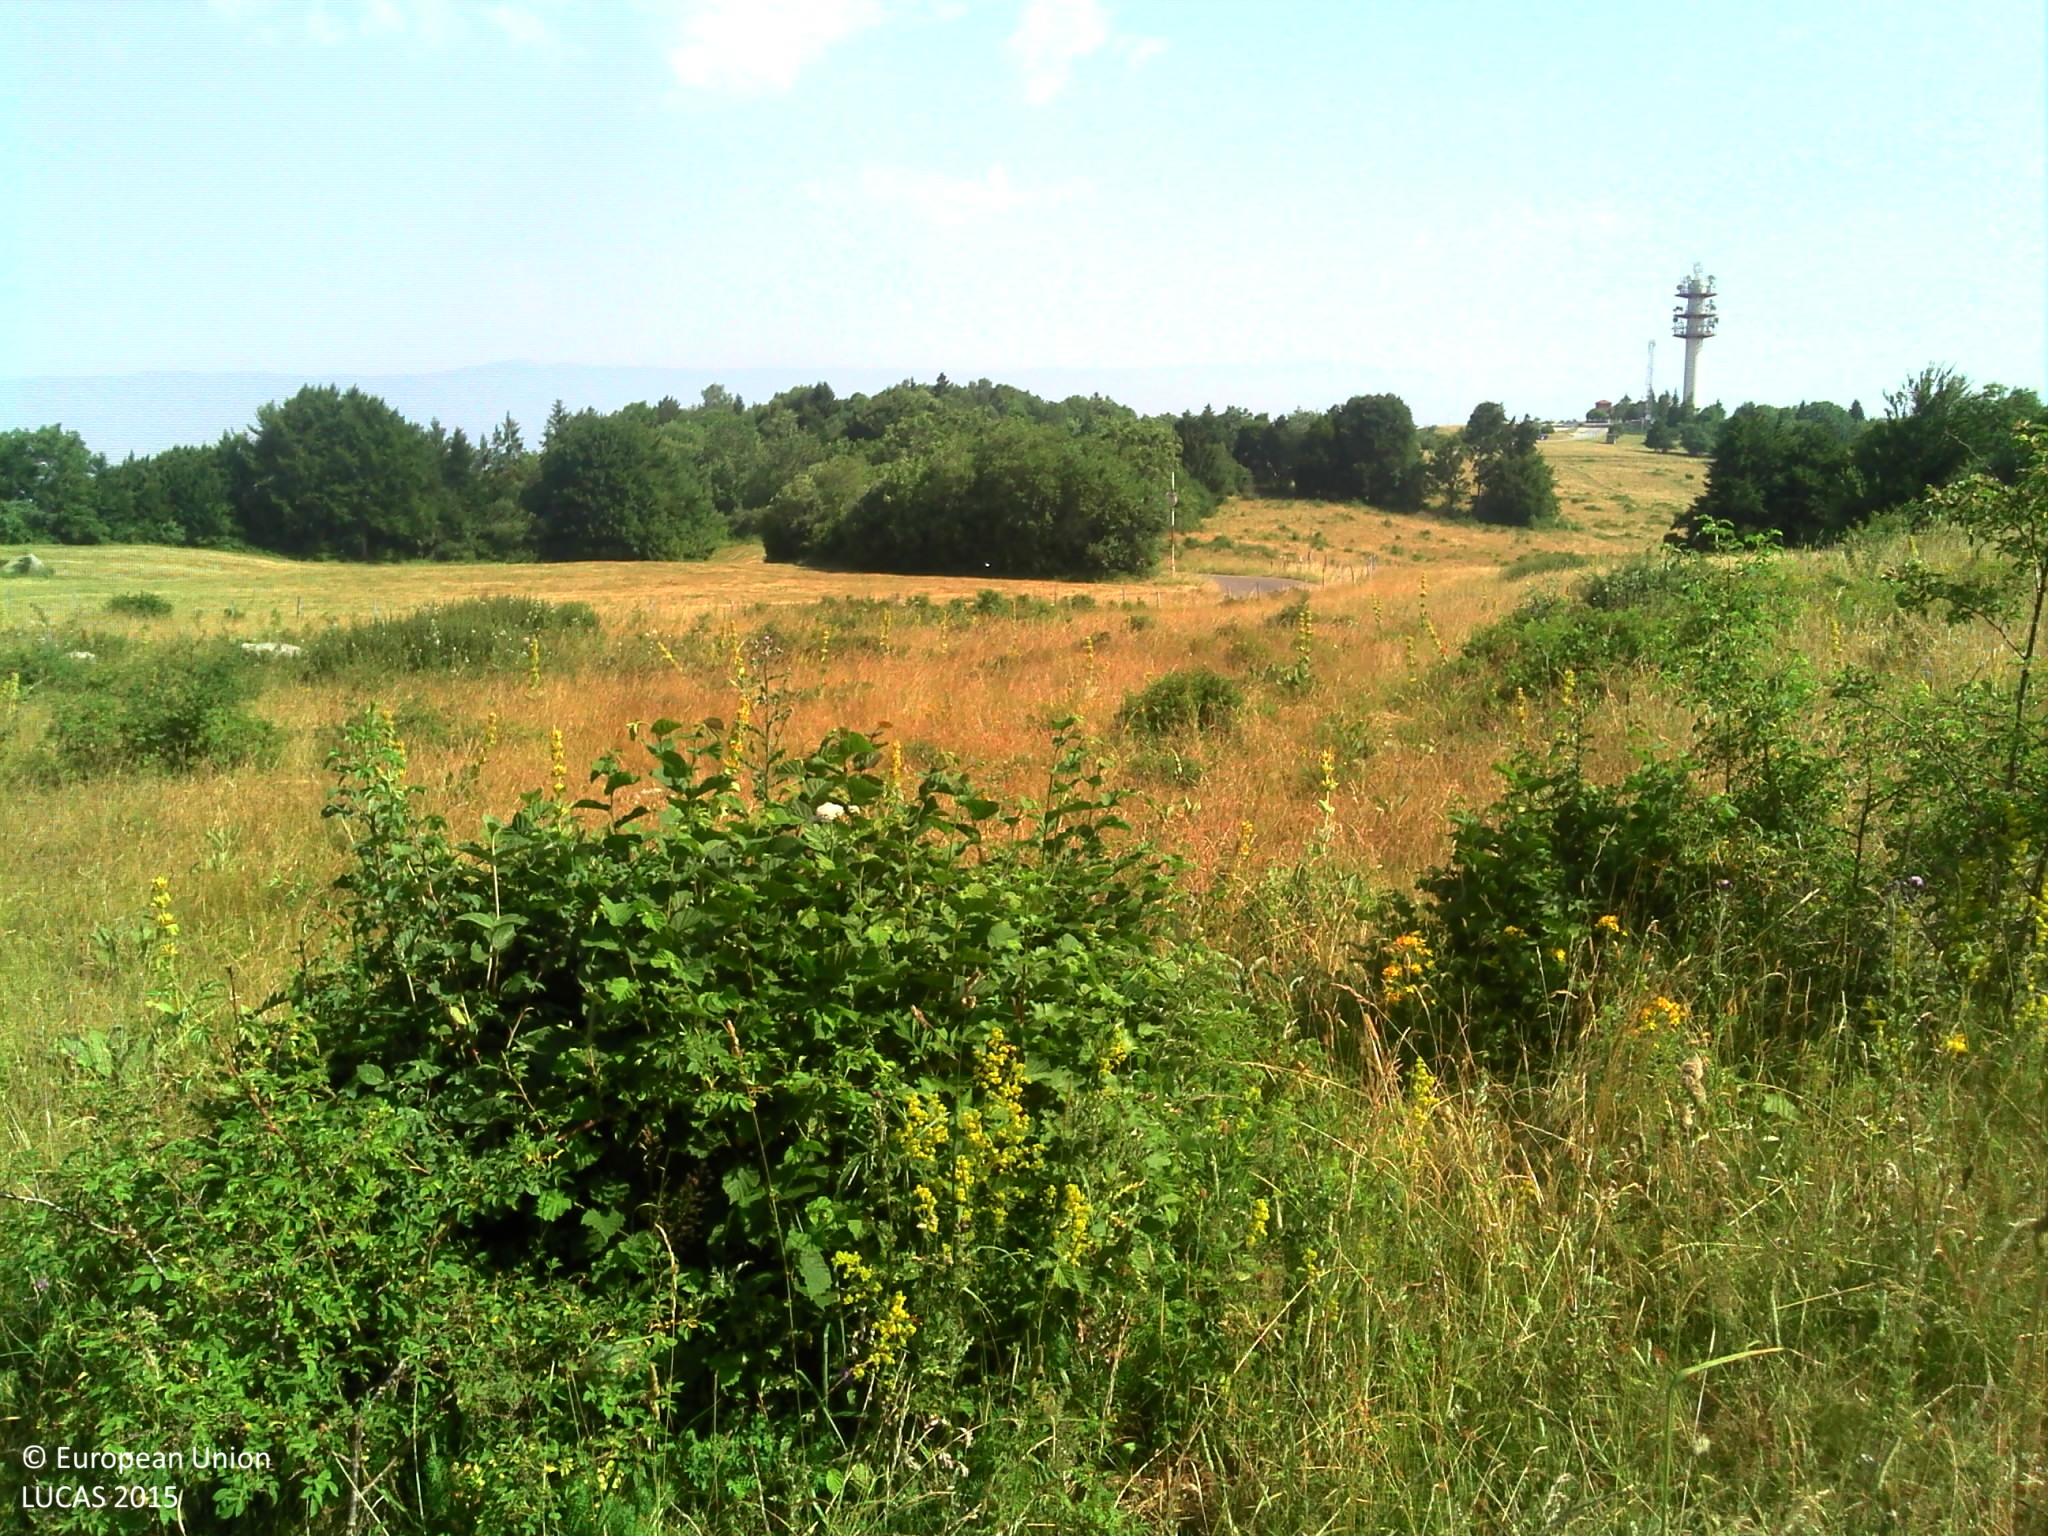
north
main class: Grassland
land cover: Grassland with sparse tree/shrub cover
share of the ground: > 75 %
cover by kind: herbaceous plants 90 %, coniferous forest trees 5 %, shrubs 5 %
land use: Agriculture (excluding fallow land and kitchen gardens)
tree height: < 5 m
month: July
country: FR
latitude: 46.1389
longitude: 6.1848
